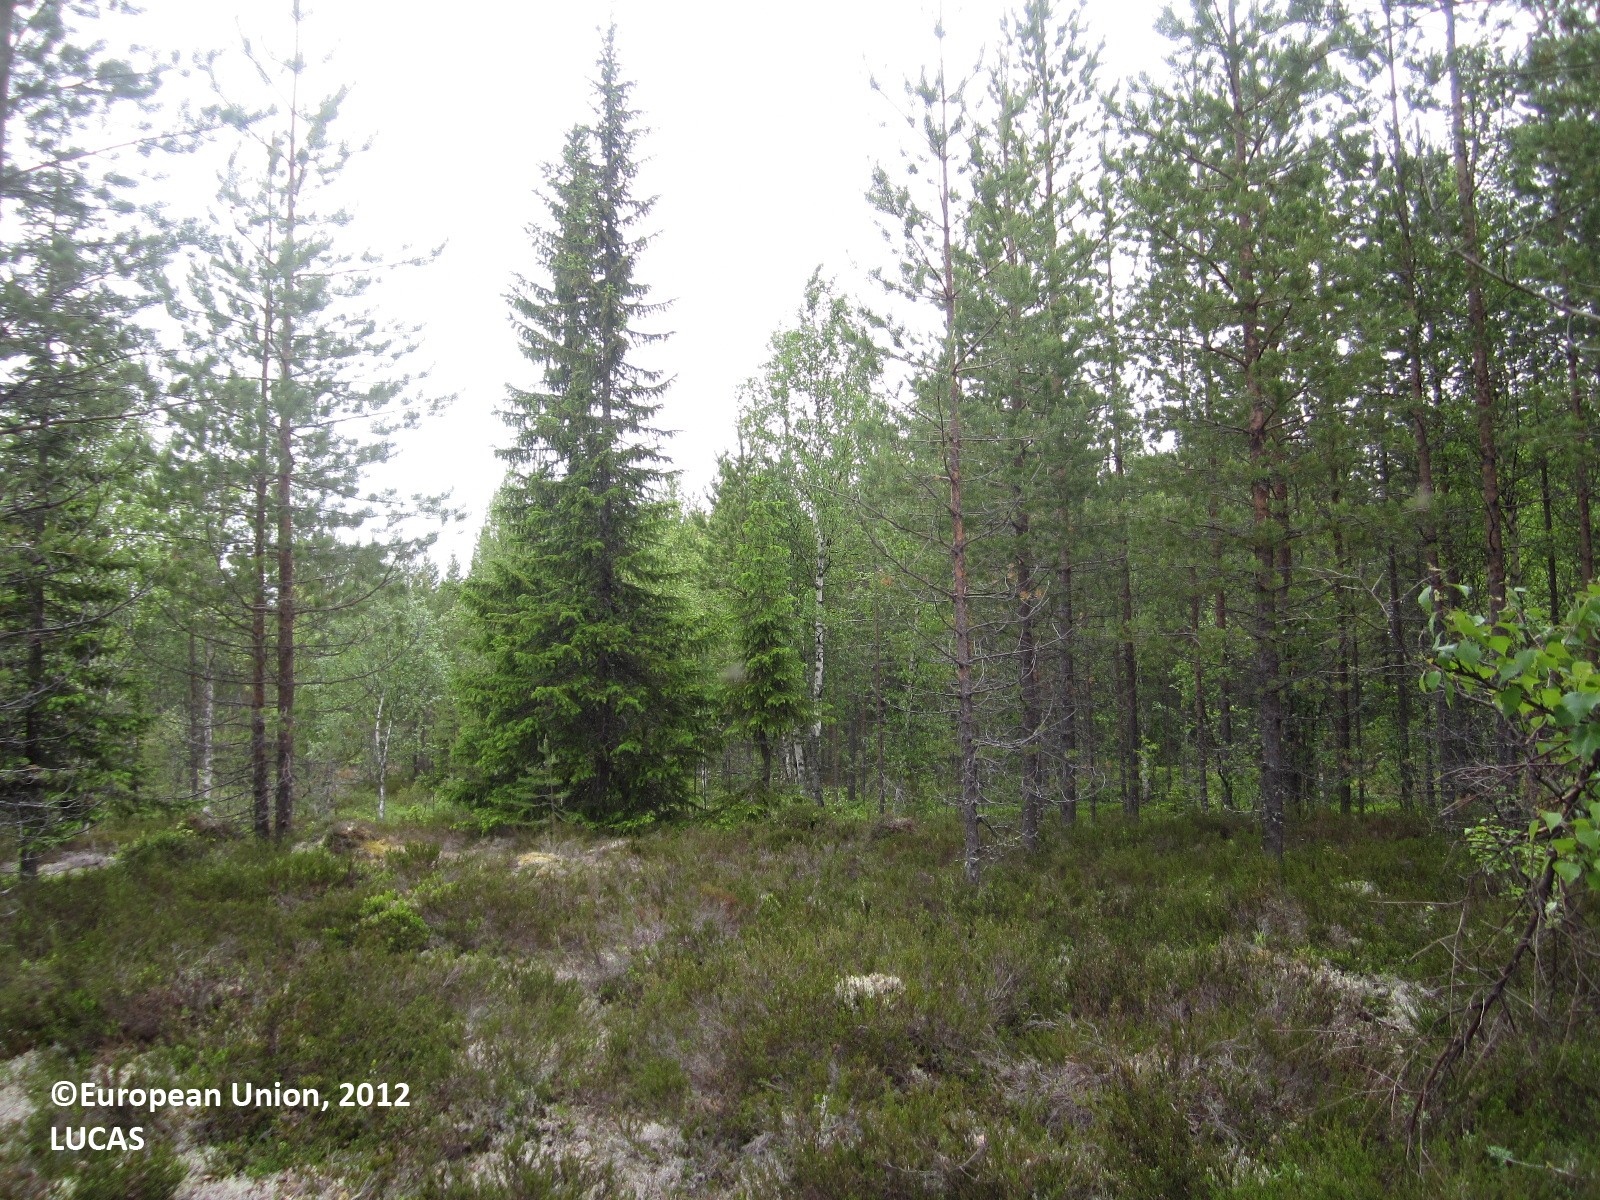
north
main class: Woodland
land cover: Pine dominated coniferous woodland
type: boreal forest
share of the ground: 25 - 50 %
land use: Forestry
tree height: > 5 m
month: June
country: FI
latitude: 64.3964
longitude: 29.5681
